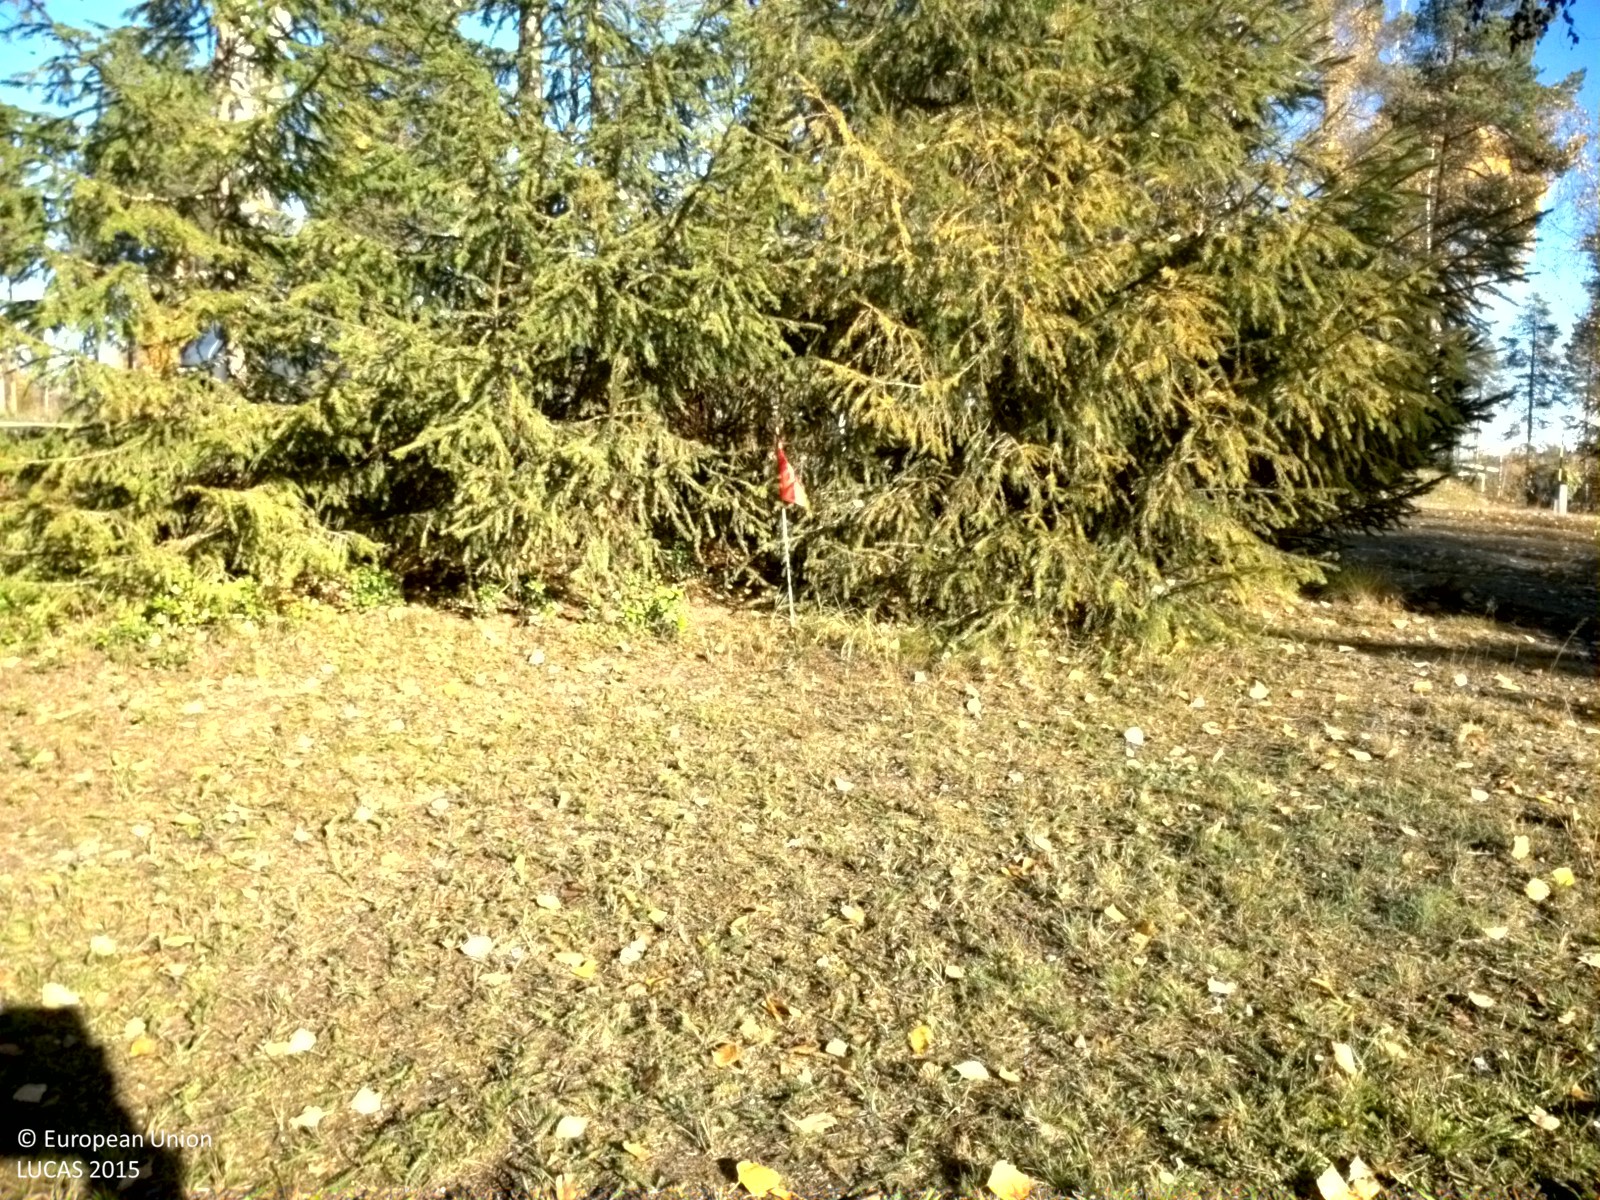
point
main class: Woodland
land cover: Spruce dominated mixed woodland
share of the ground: 50 - 75 %
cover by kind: coniferous forest trees 40 %, shrubs 30 %, broadleaved forest trees 20 %, herbaceous plants 10 %
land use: Residential
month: October
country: SE
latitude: 65.7620
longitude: 21.3876
